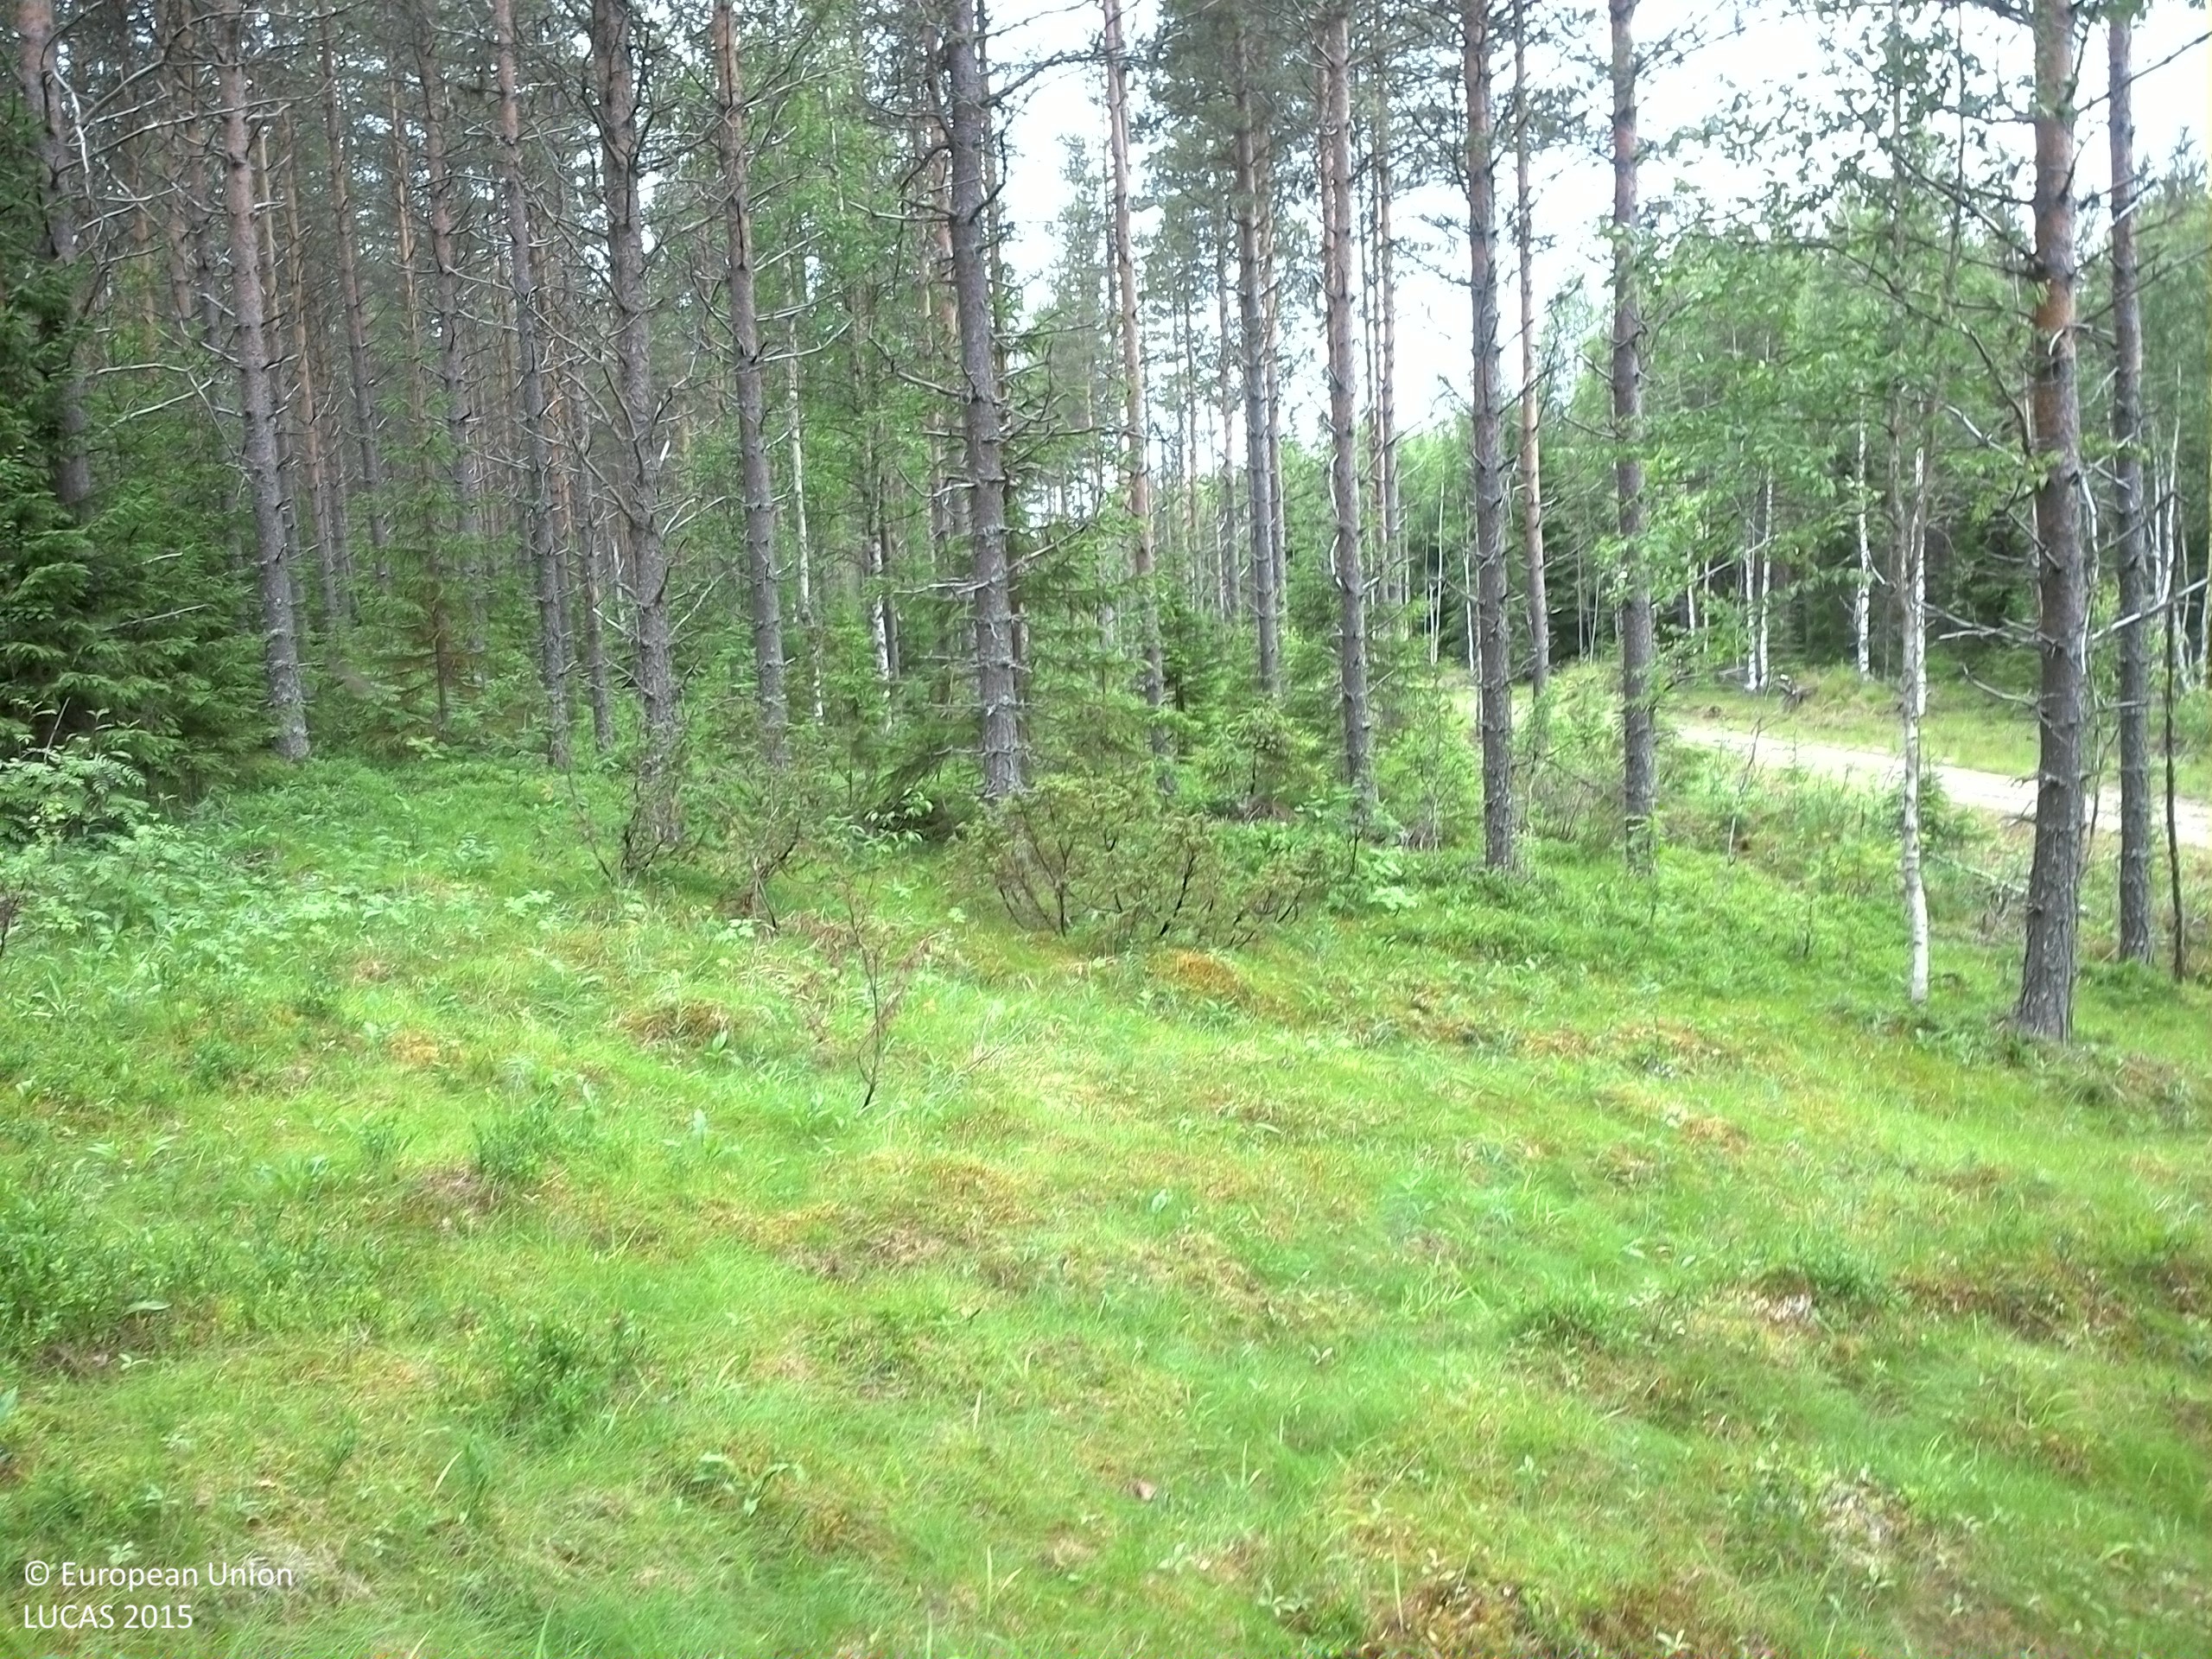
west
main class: Woodland
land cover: Pine dominated coniferous woodland
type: boreal forest
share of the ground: 50 - 75 %
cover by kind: coniferous forest trees 55 %, herbaceous plants 15 %, broadleaved forest trees 10 %, shrubs 10 %, lichens and mosses 10 %
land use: Forestry
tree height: > 5 m
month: July
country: SE
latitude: 63.6111
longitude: 18.7482
